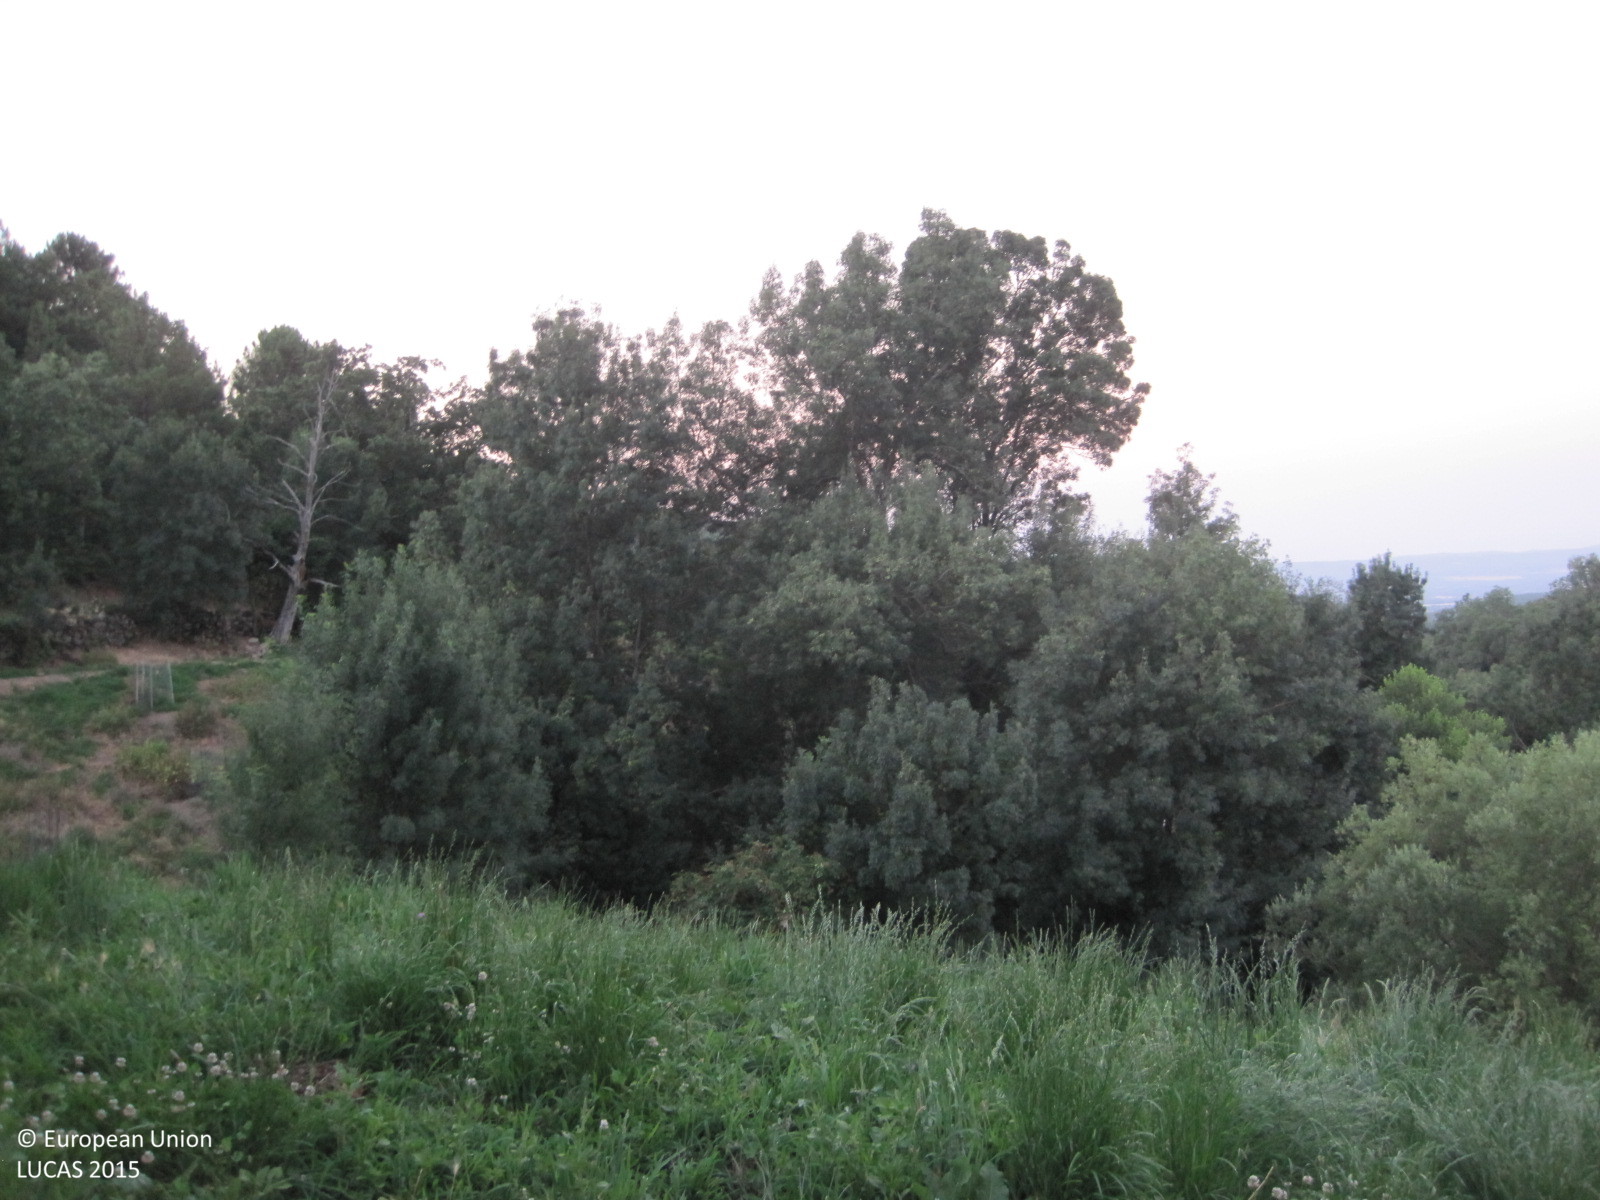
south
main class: Grassland
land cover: Grassland with sparse tree/shrub cover
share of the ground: > 75 %
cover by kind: herbaceous plants 95 %, broadleaved forest trees 5 %
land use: Agriculture (excluding fallow land and kitchen gardens)
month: July
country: ES
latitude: 40.2885
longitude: -4.8386
